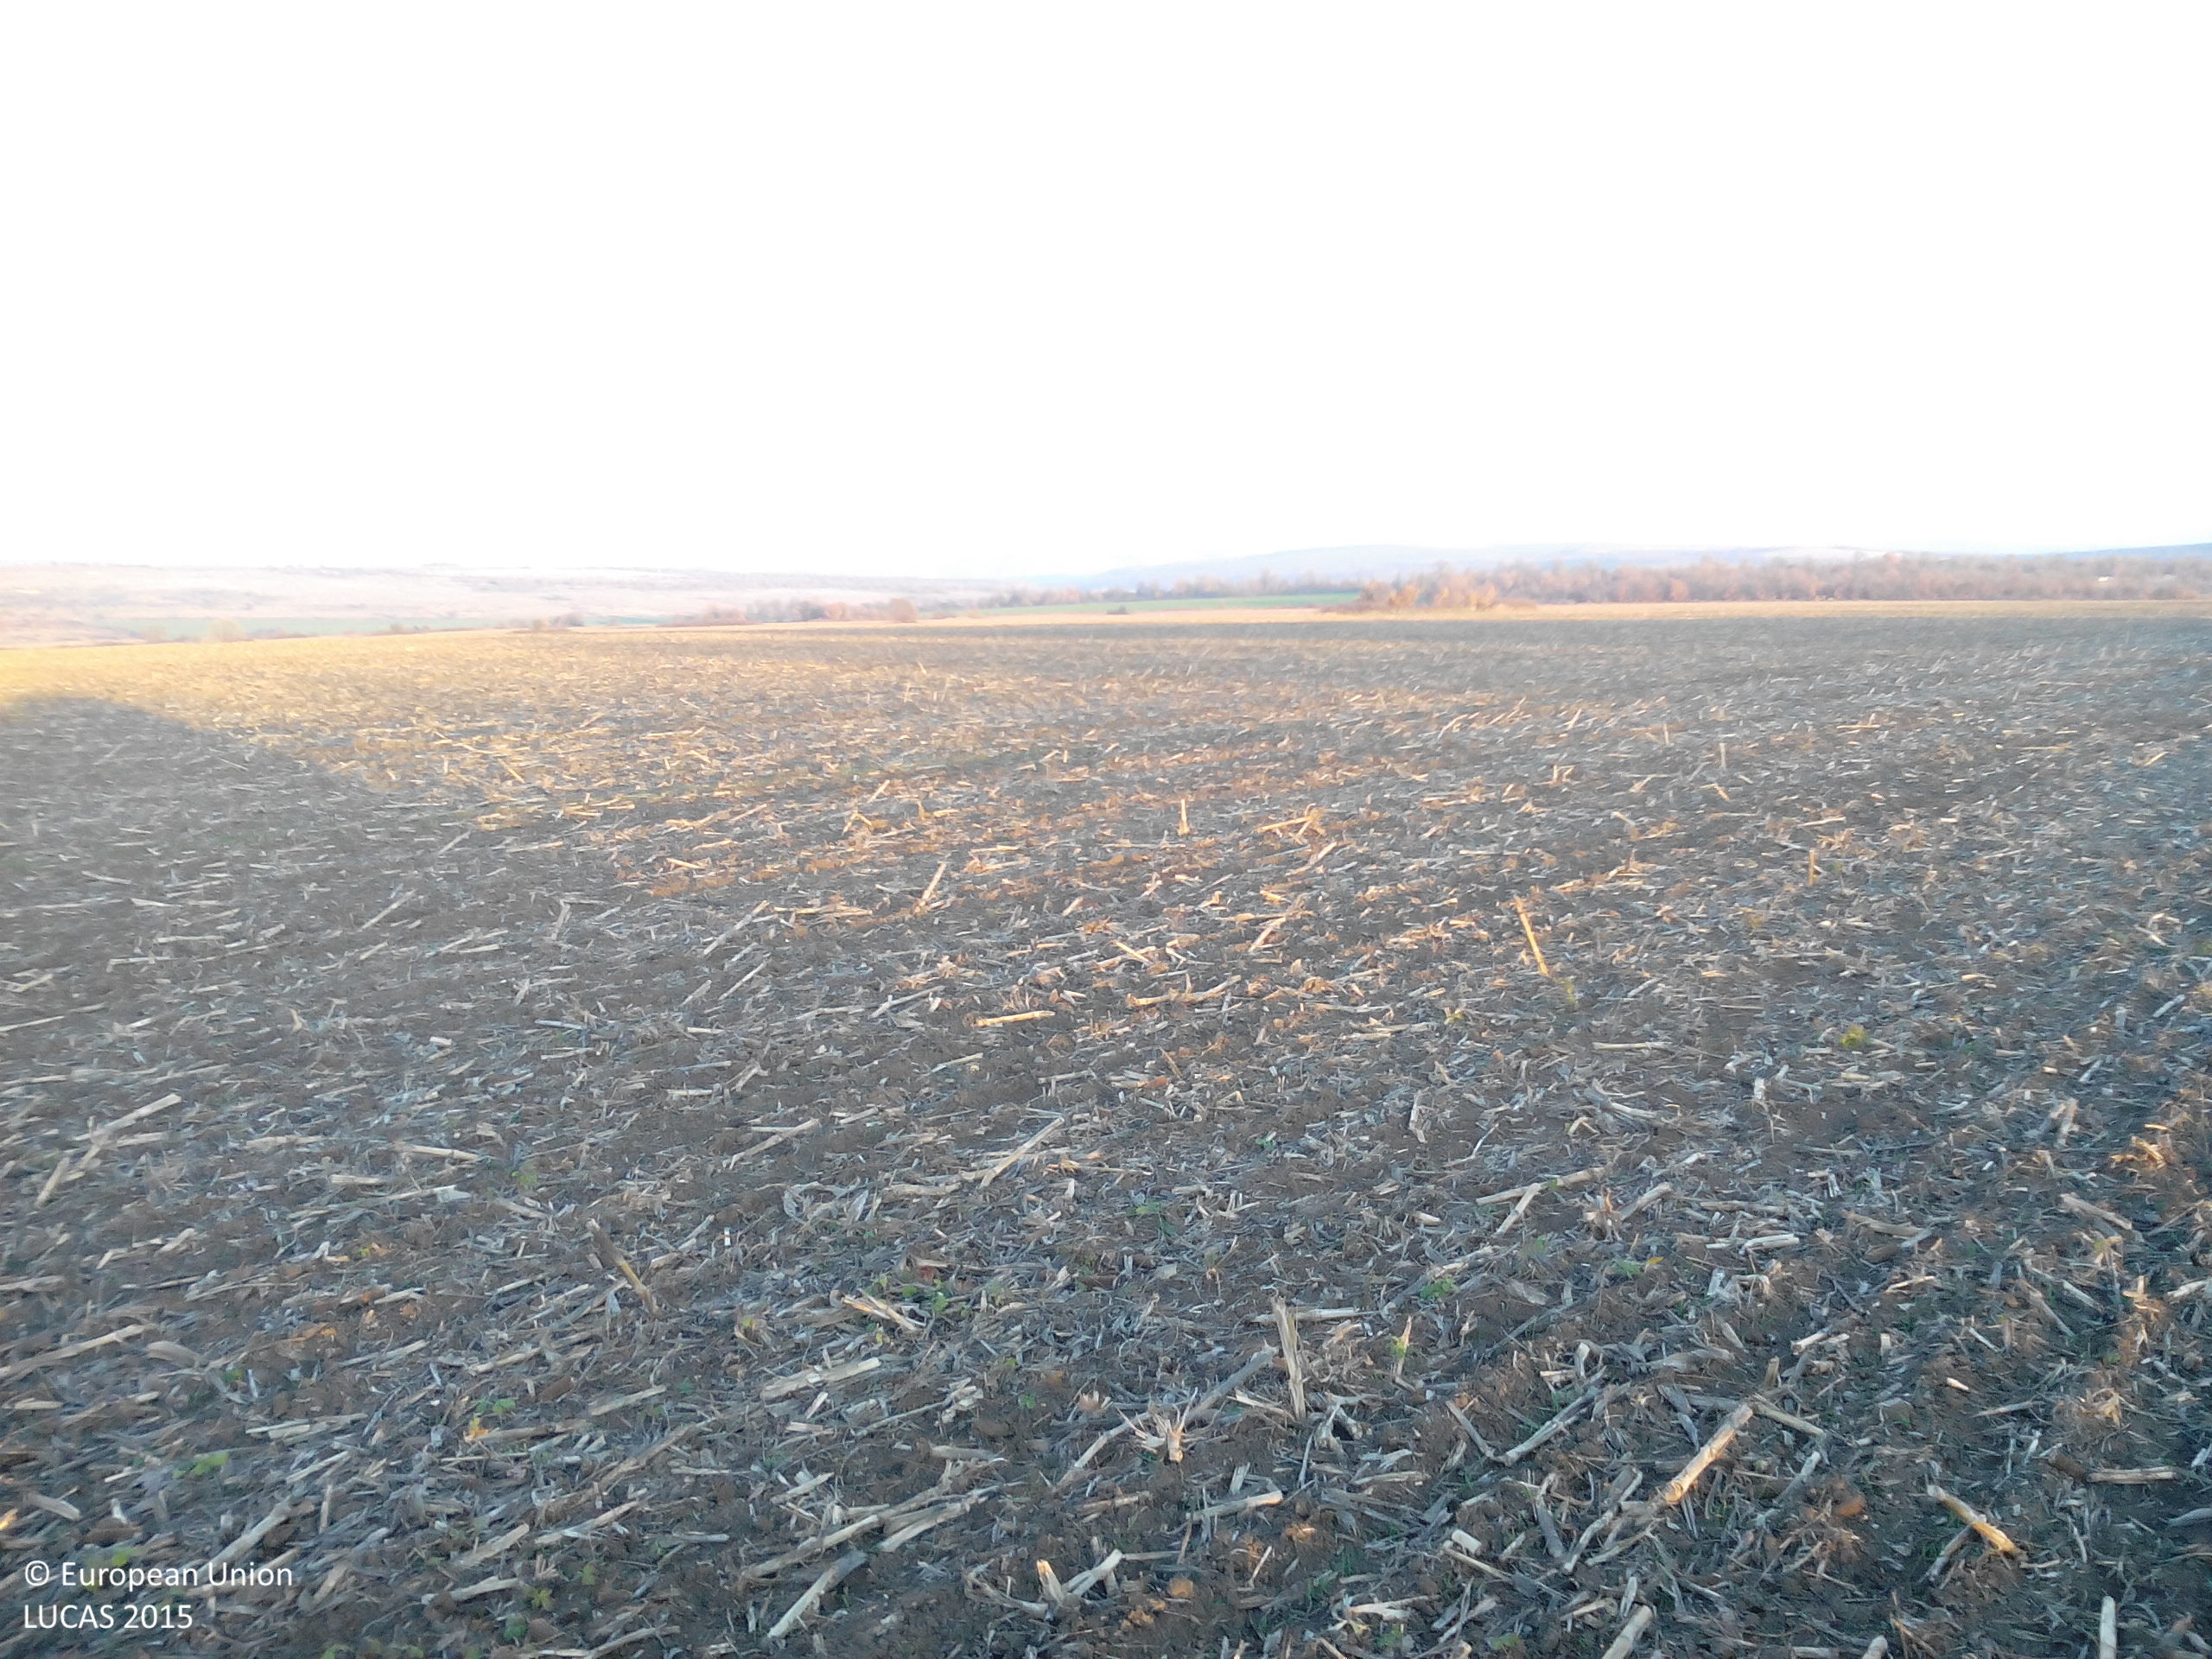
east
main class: Cropland
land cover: Maize
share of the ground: < 10 %
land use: Agriculture (excluding fallow land and kitchen gardens)
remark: Harvested field
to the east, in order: Maize
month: November
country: BG
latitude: 43.2380
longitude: 23.9523
